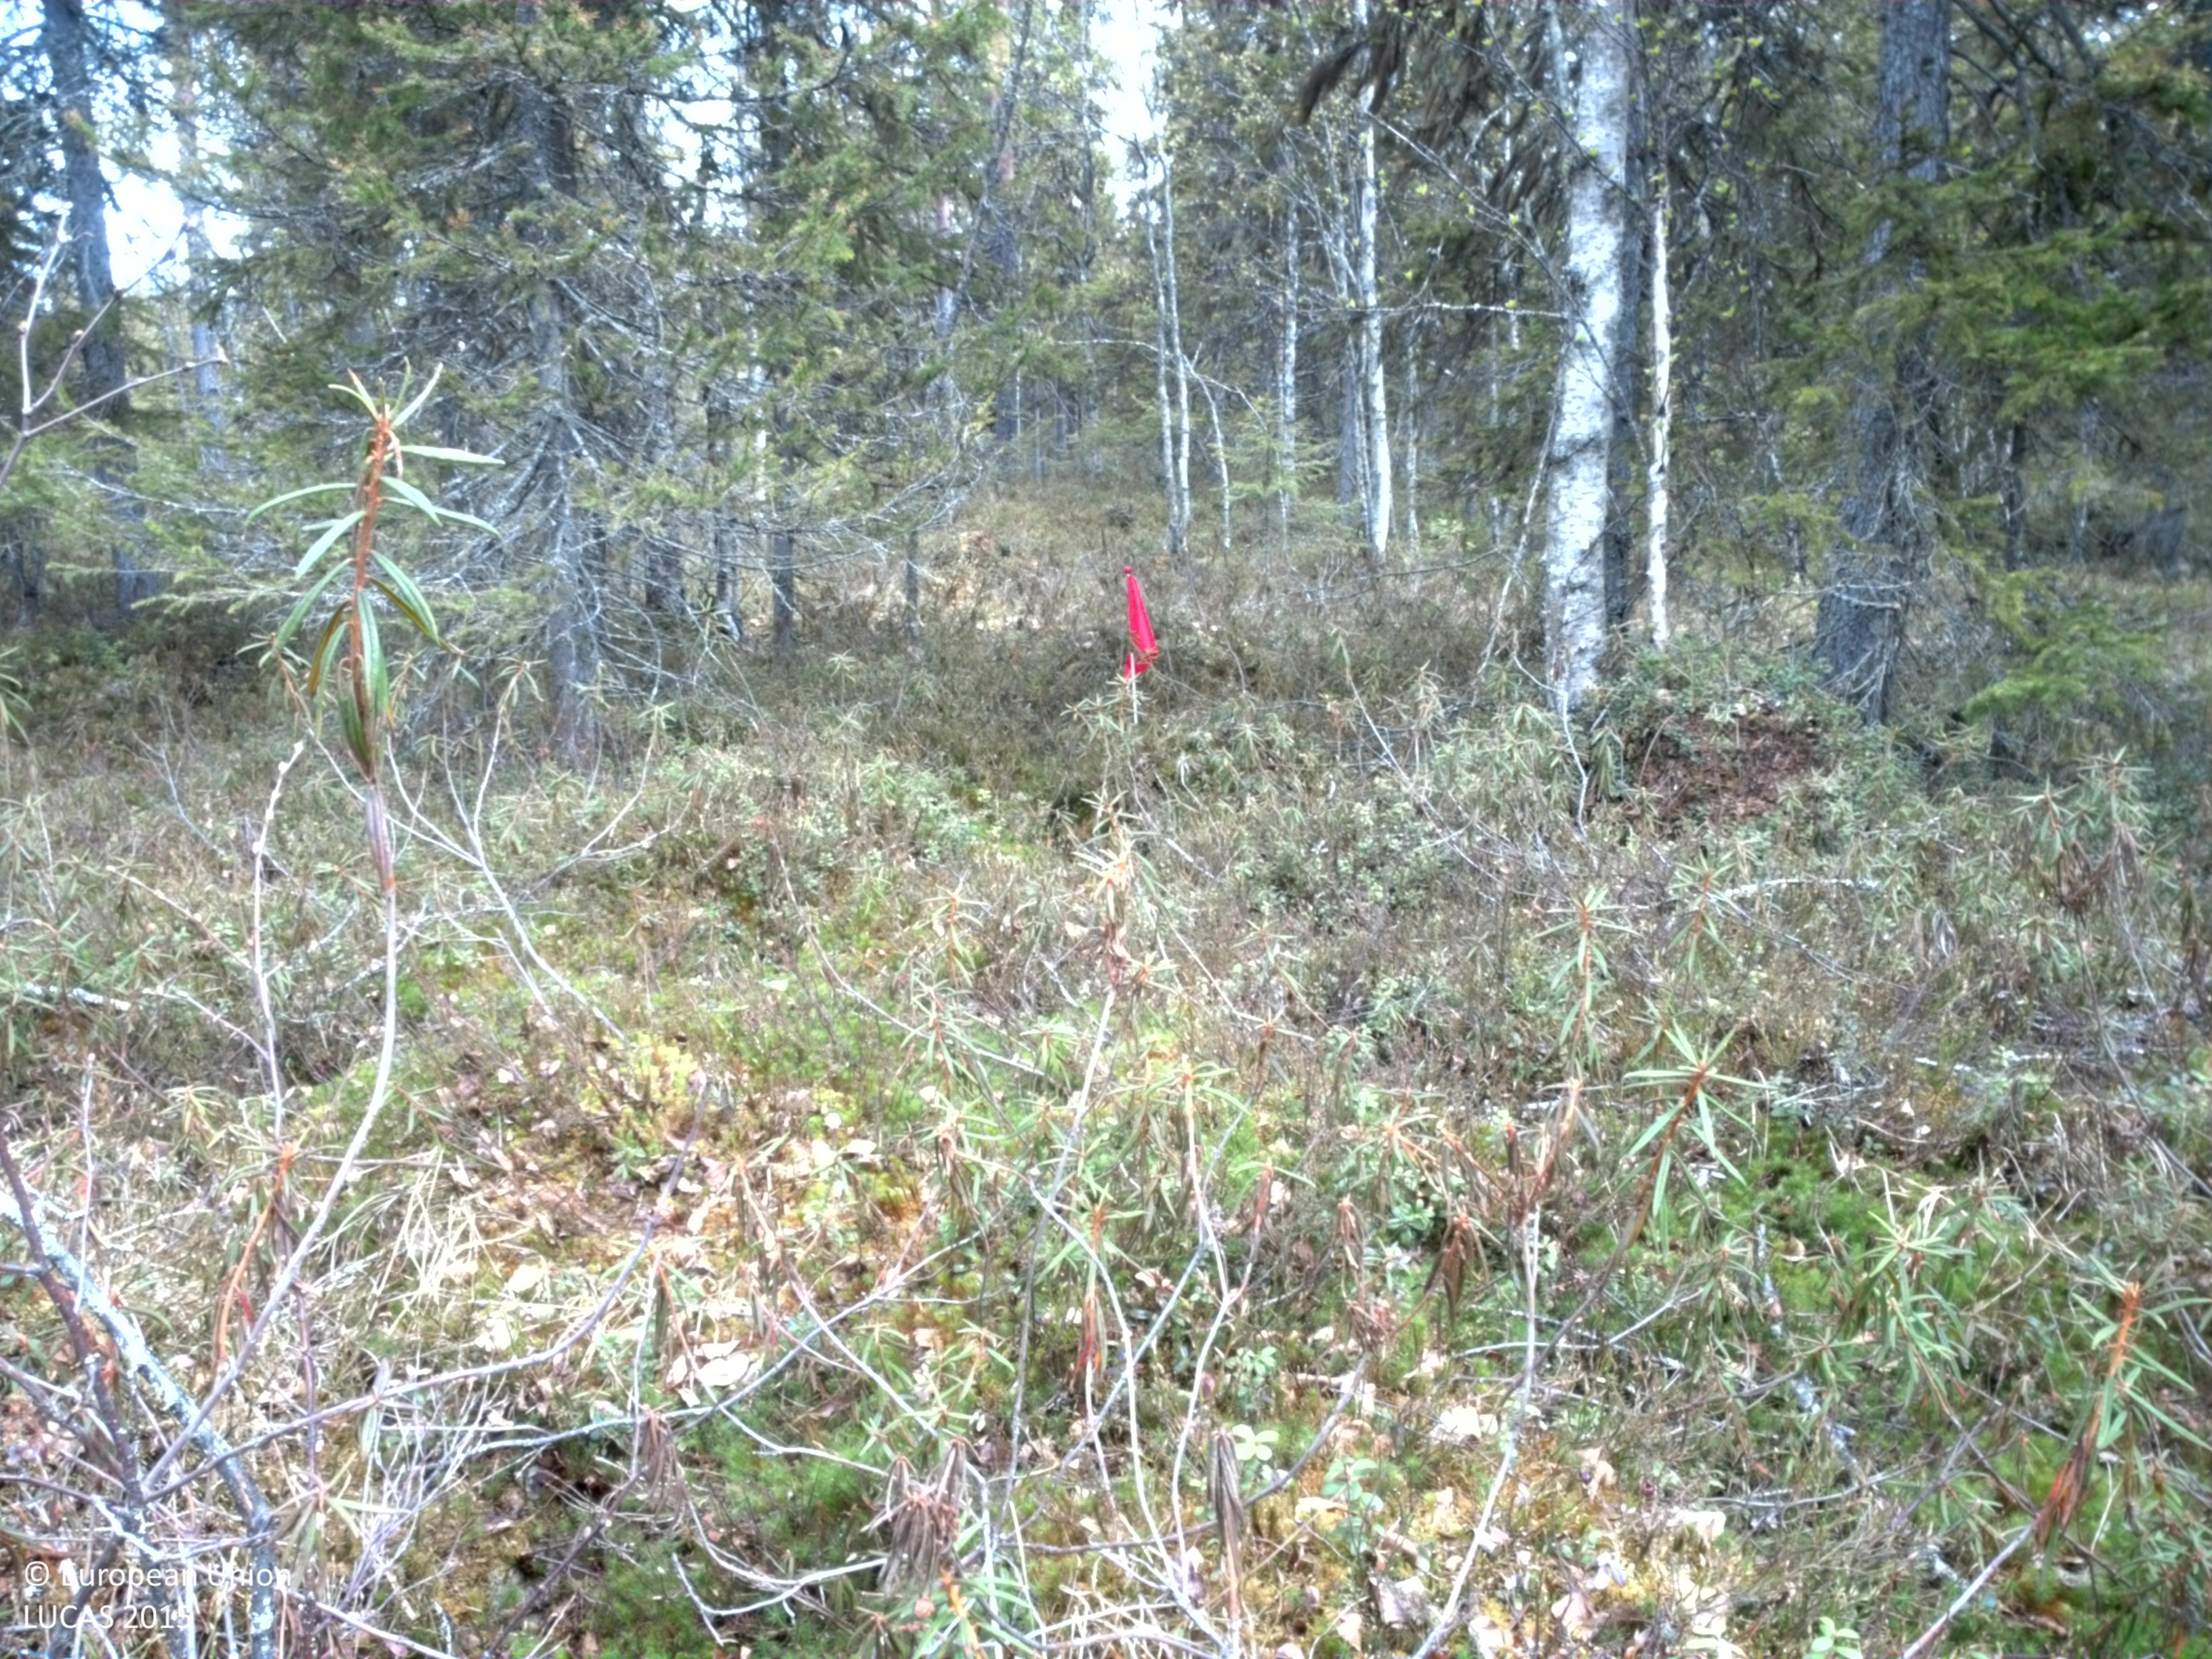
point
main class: Woodland
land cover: Spruce dominated mixed woodland
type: boreal forest
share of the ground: 50 - 75 %
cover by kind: coniferous forest trees 50 %, broadleaved forest trees 25 %, shrubs 25 %
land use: Forestry
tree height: > 5 m
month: June
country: SE
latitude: 66.4735
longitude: 23.4311
